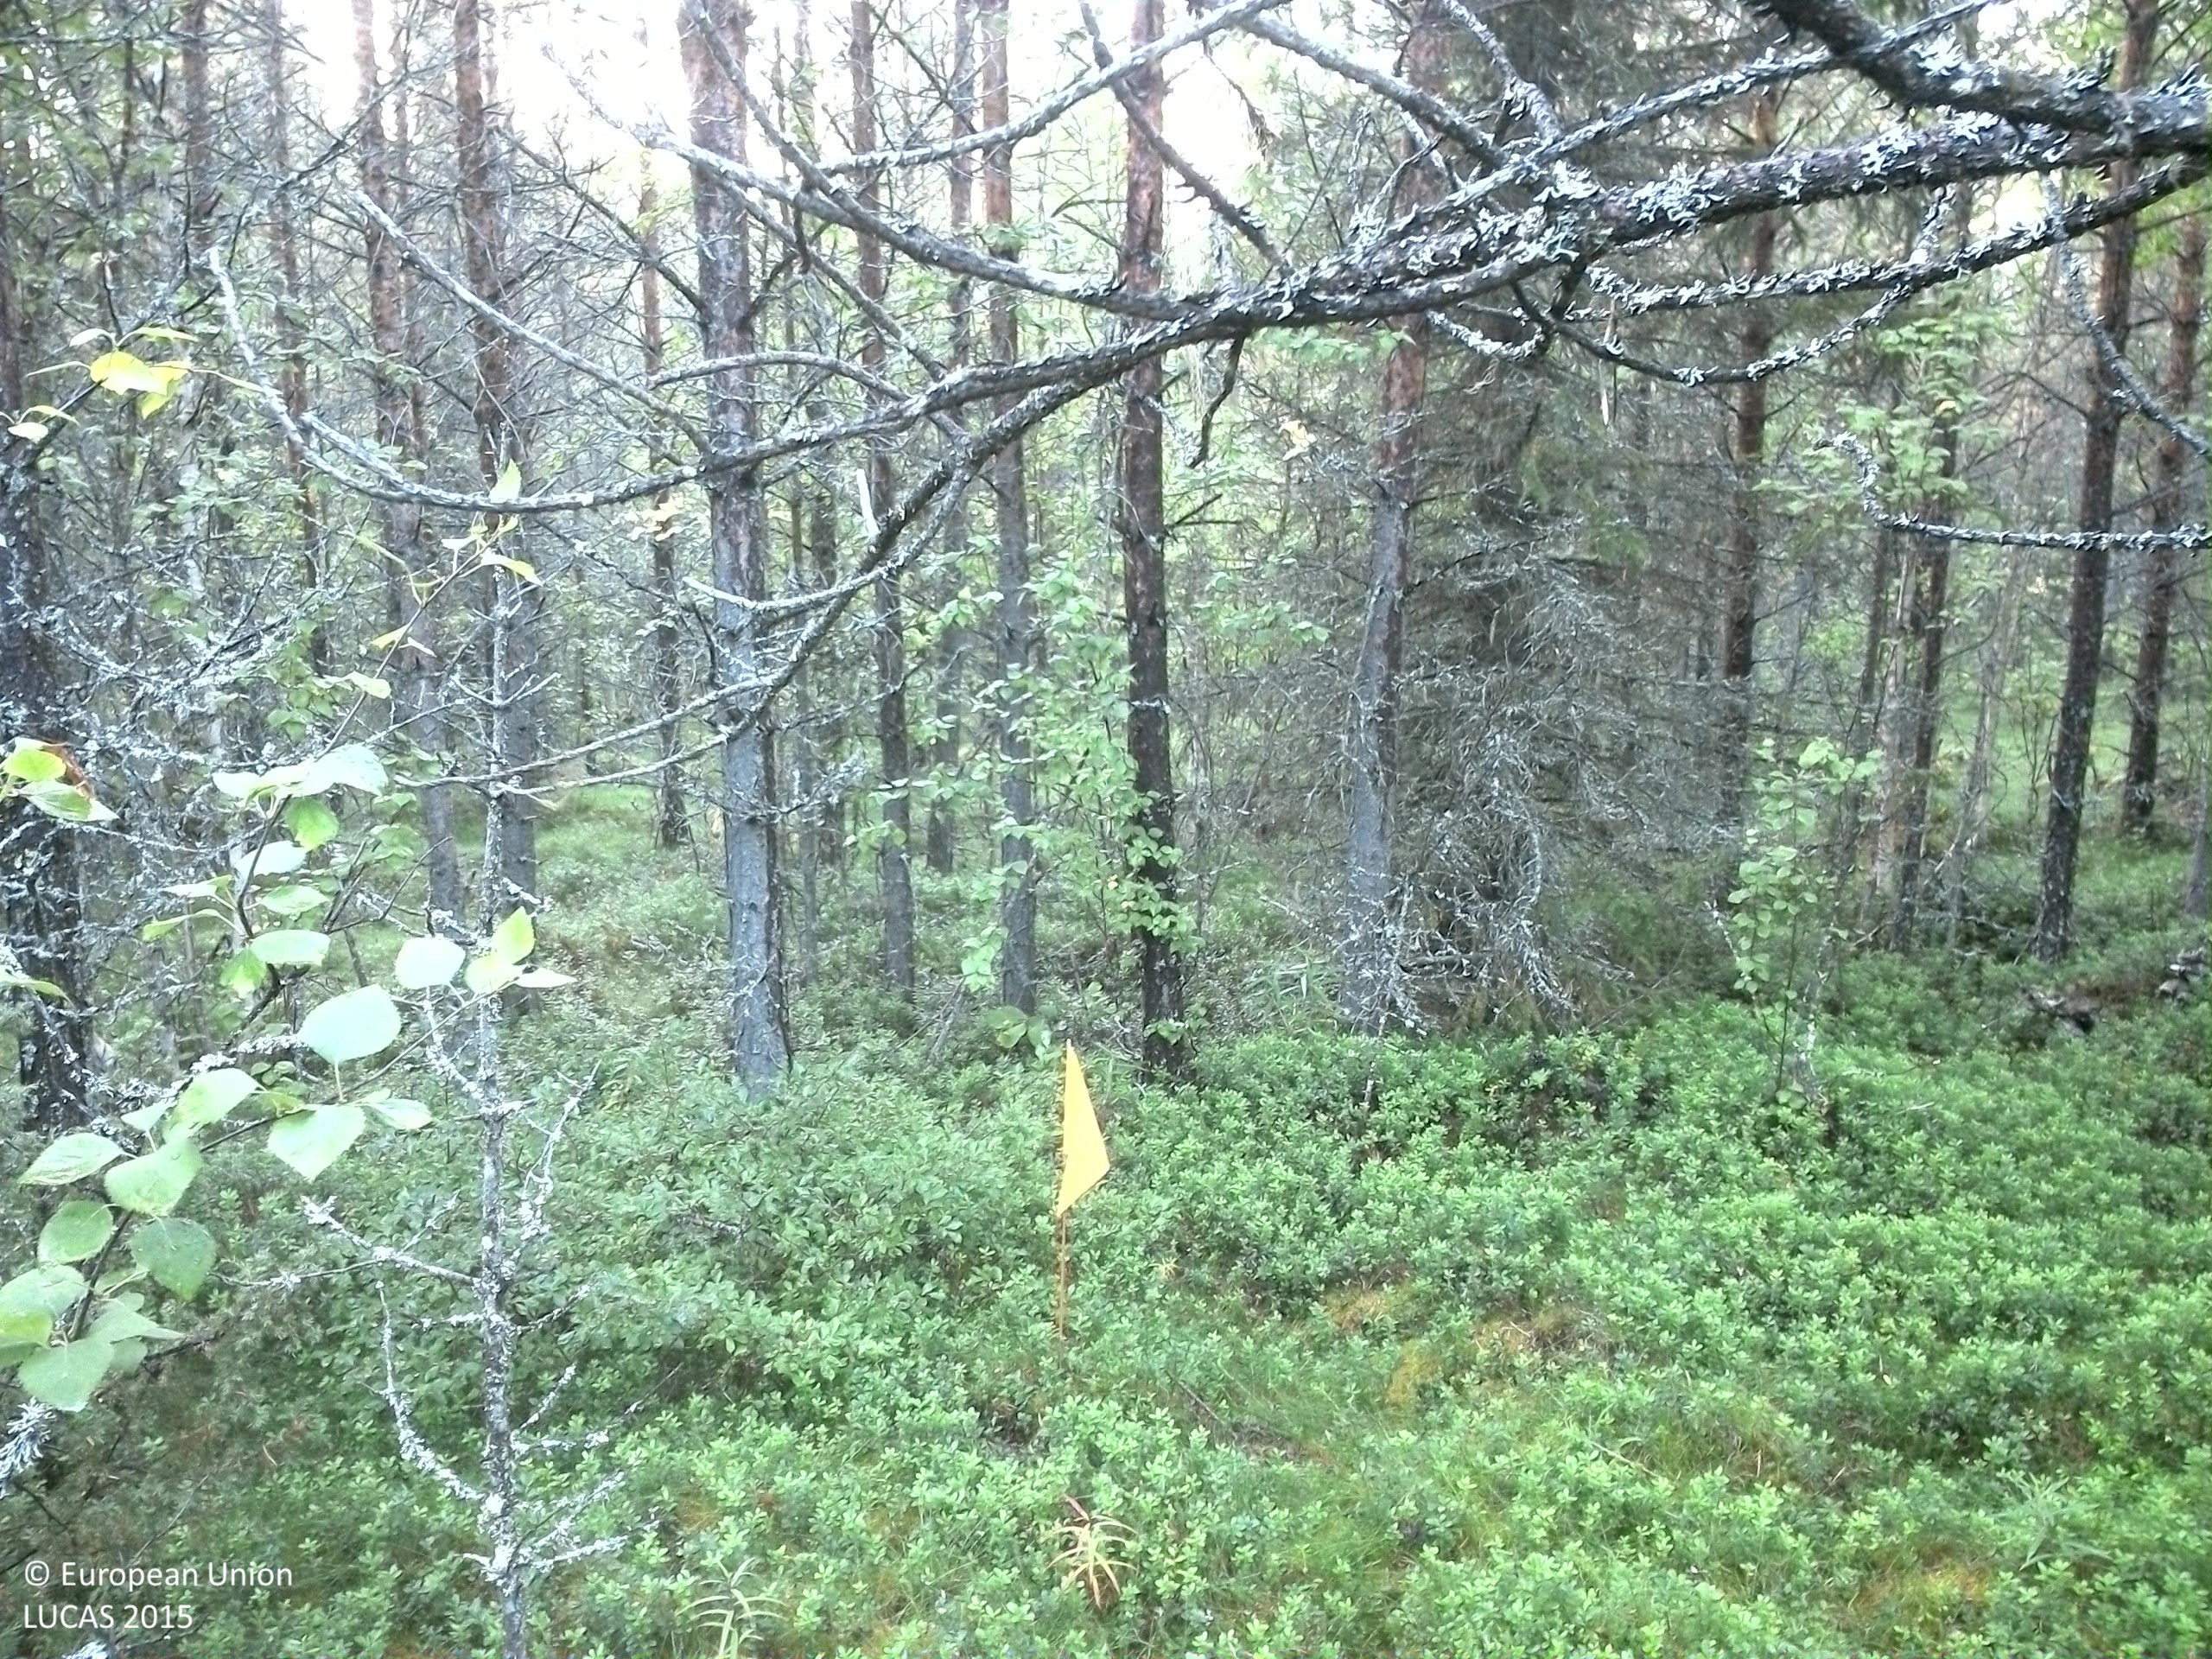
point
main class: Woodland
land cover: Pine dominated coniferous woodland
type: boreal forest
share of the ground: > 75 %
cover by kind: coniferous forest trees 80 %, shrubs 15 %, broadleaved forest trees 5 %
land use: Forestry
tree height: > 5 m
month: August
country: SE
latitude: 63.8665
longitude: 17.3174
